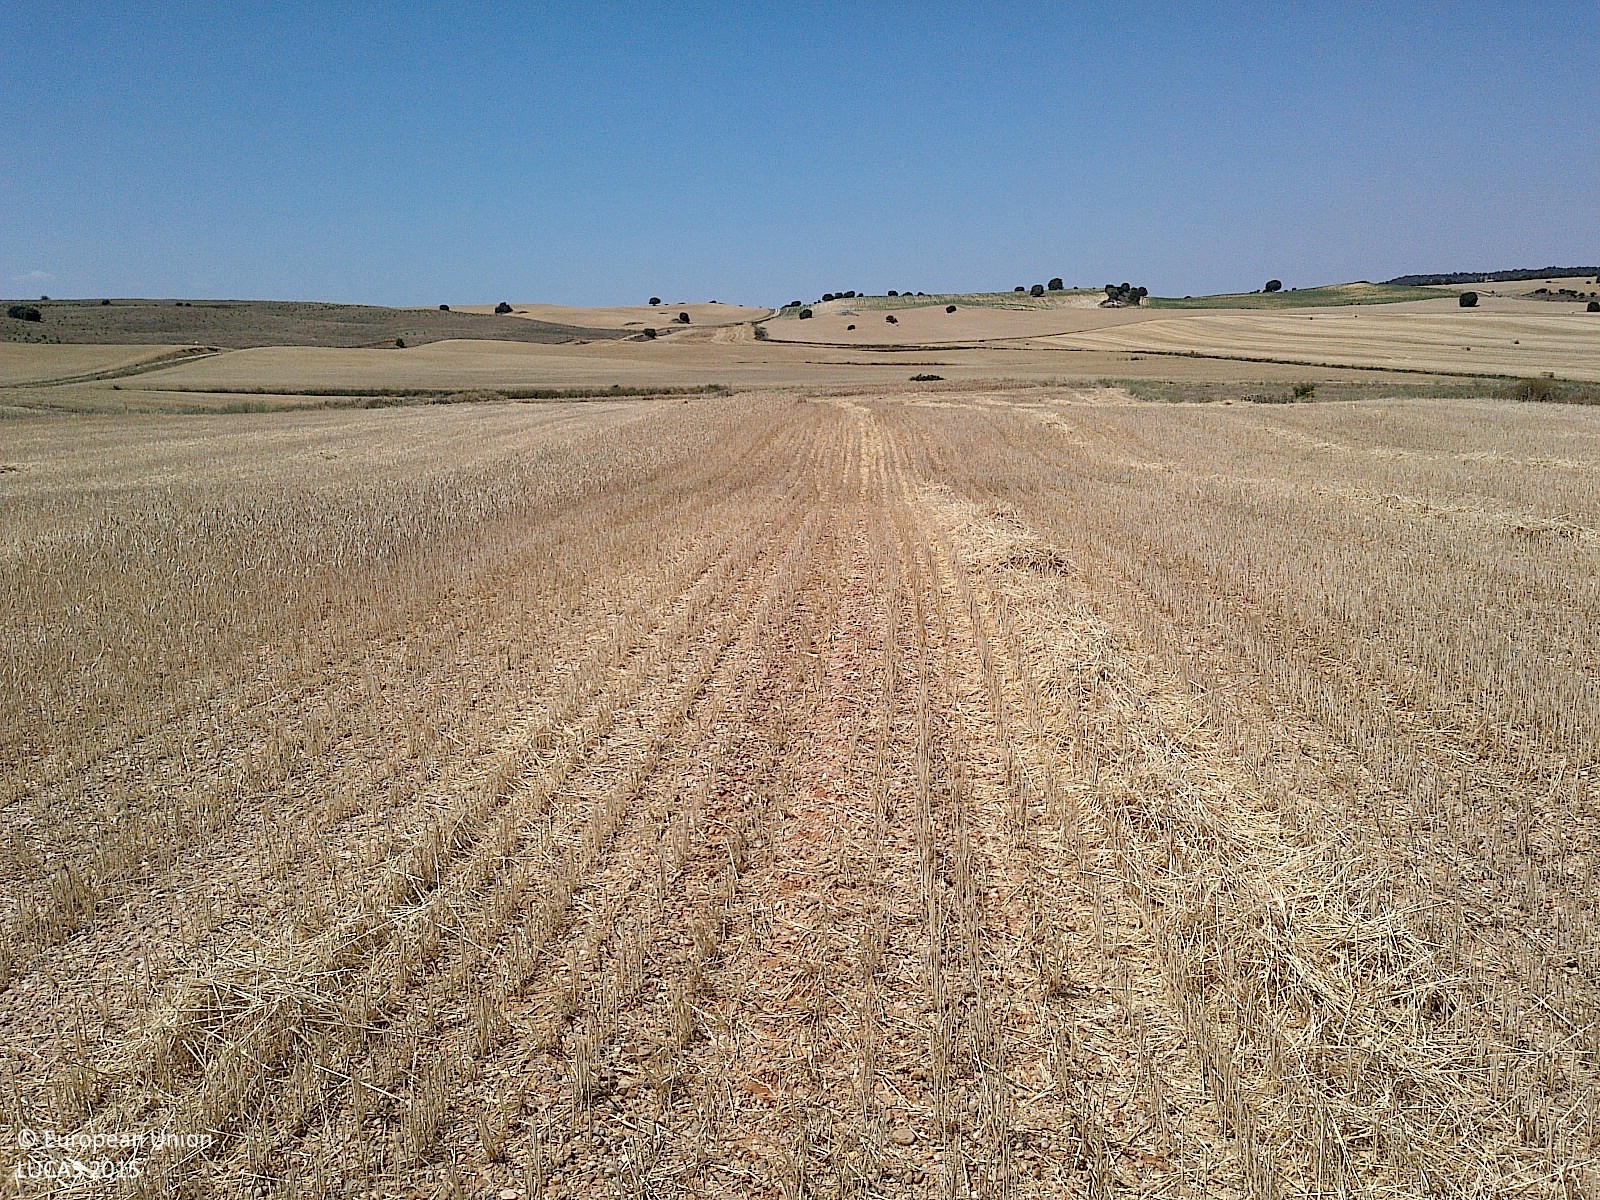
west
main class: Cropland
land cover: Common wheat
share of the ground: < 10 %
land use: Agriculture (excluding fallow land and kitchen gardens)
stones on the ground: 10 - 25 %
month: July
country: ES
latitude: 41.7411
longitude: -3.2622
